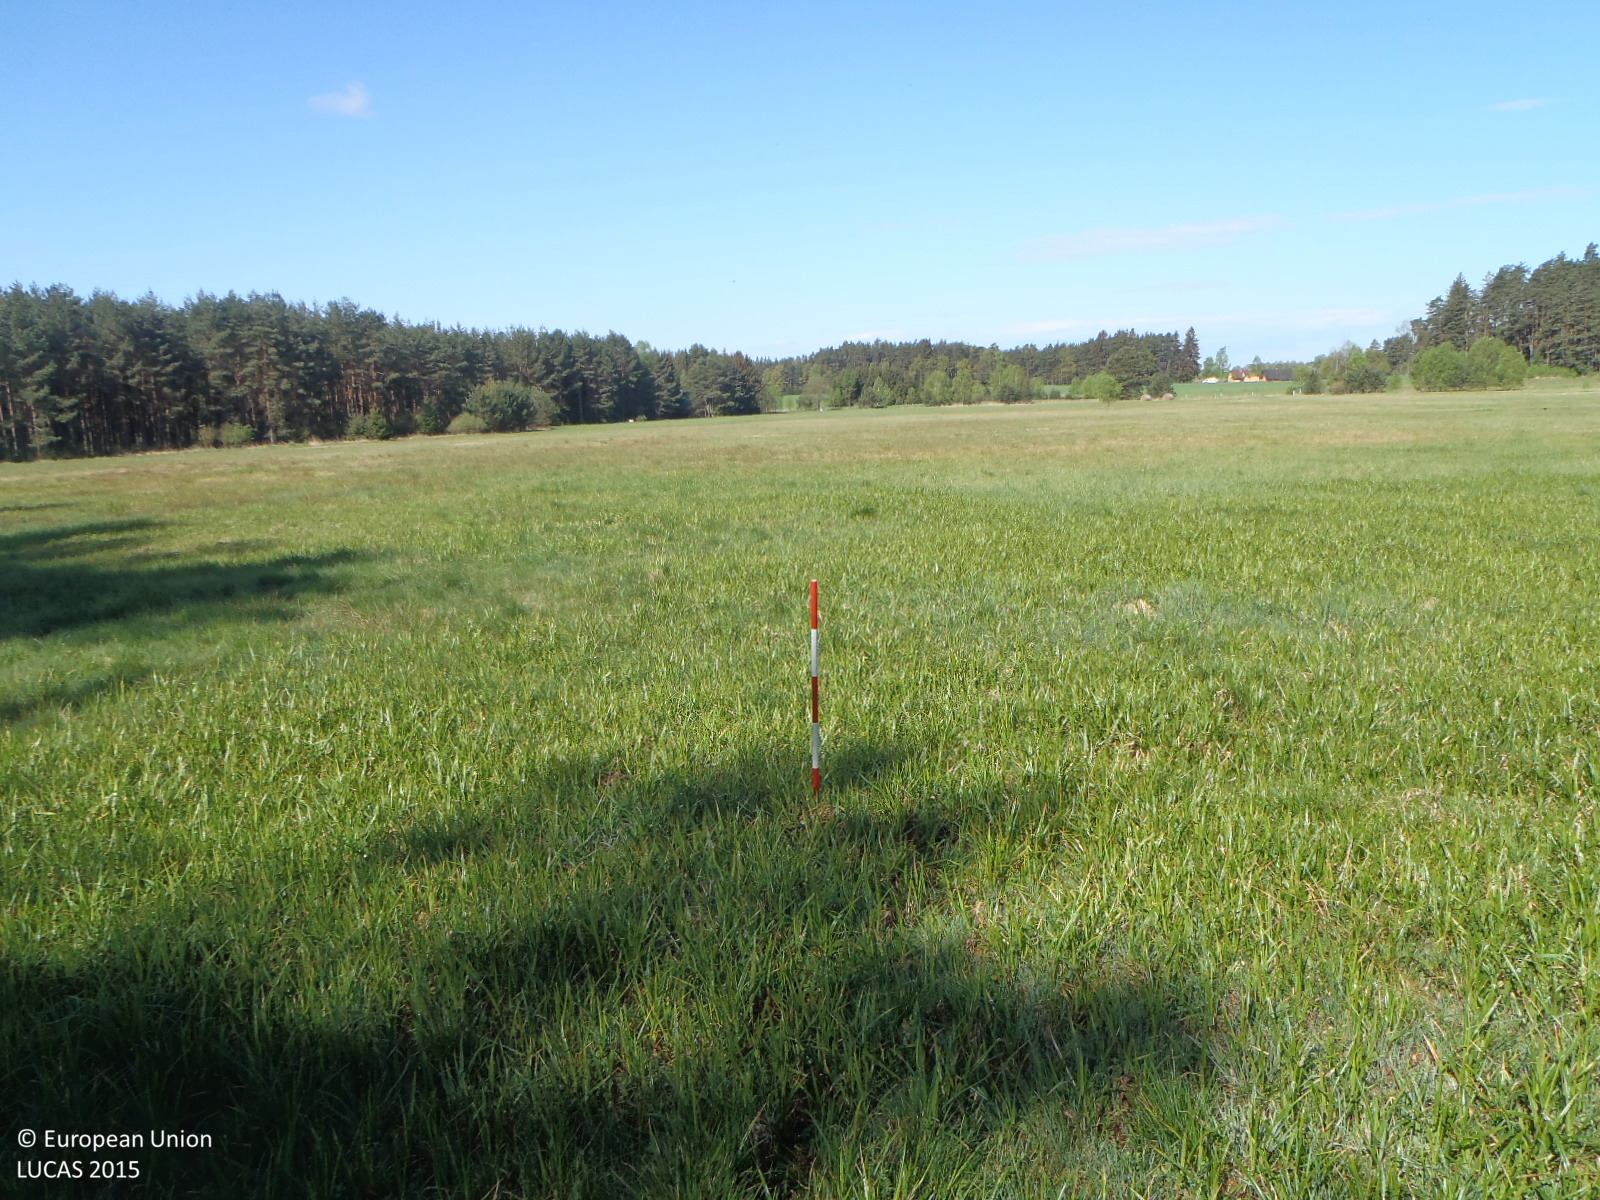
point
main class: Grassland
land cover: Grassland without tree/shrub cover
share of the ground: > 75 %
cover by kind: herbaceous plants 100 %
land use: Agriculture (excluding fallow land and kitchen gardens)
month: May
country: CZ
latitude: 49.0990
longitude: 15.0562
